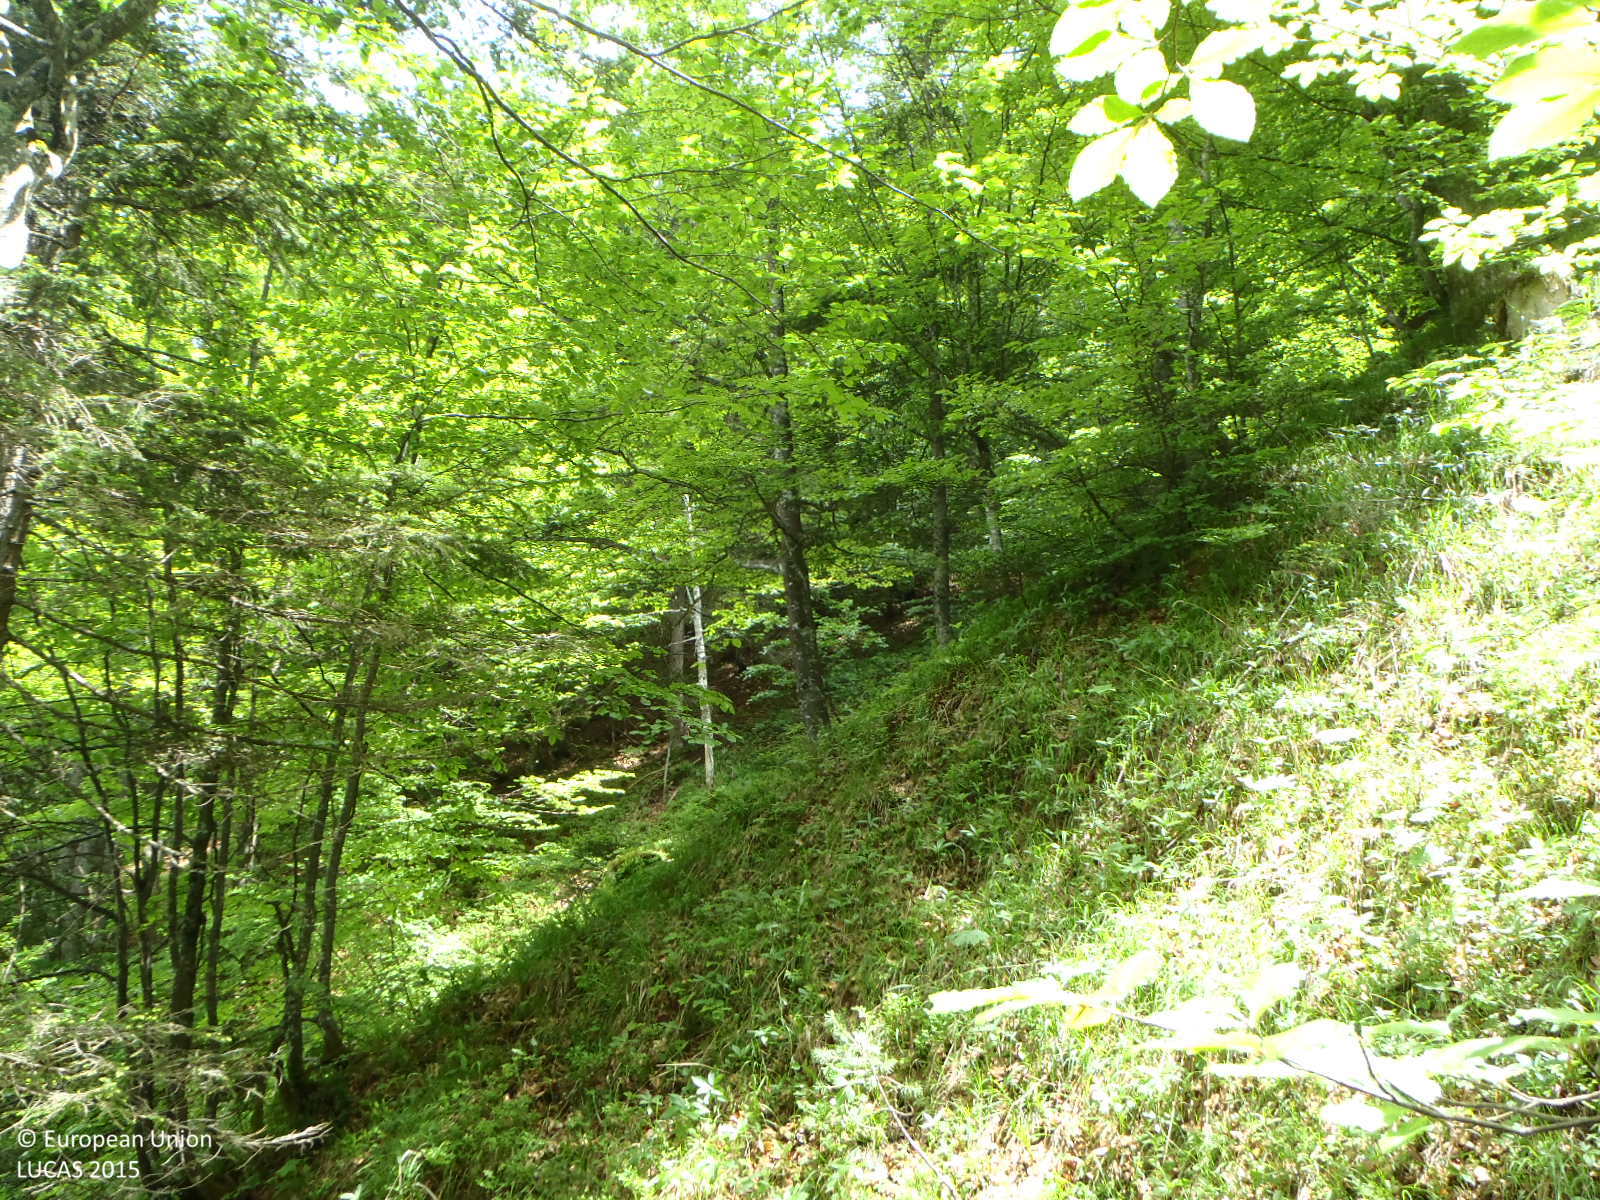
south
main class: Woodland
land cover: Other mixed woodland
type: beech forest
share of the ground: > 75 %
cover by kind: coniferous forest trees 40 %, broadleaved forest trees 40 %, herbaceous plants 10 %, shrubs 5 %, lichens and mosses 5 %
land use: Forestry
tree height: > 5 m
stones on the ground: < 10 %
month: June
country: AT
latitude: 47.5083
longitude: 12.6139
